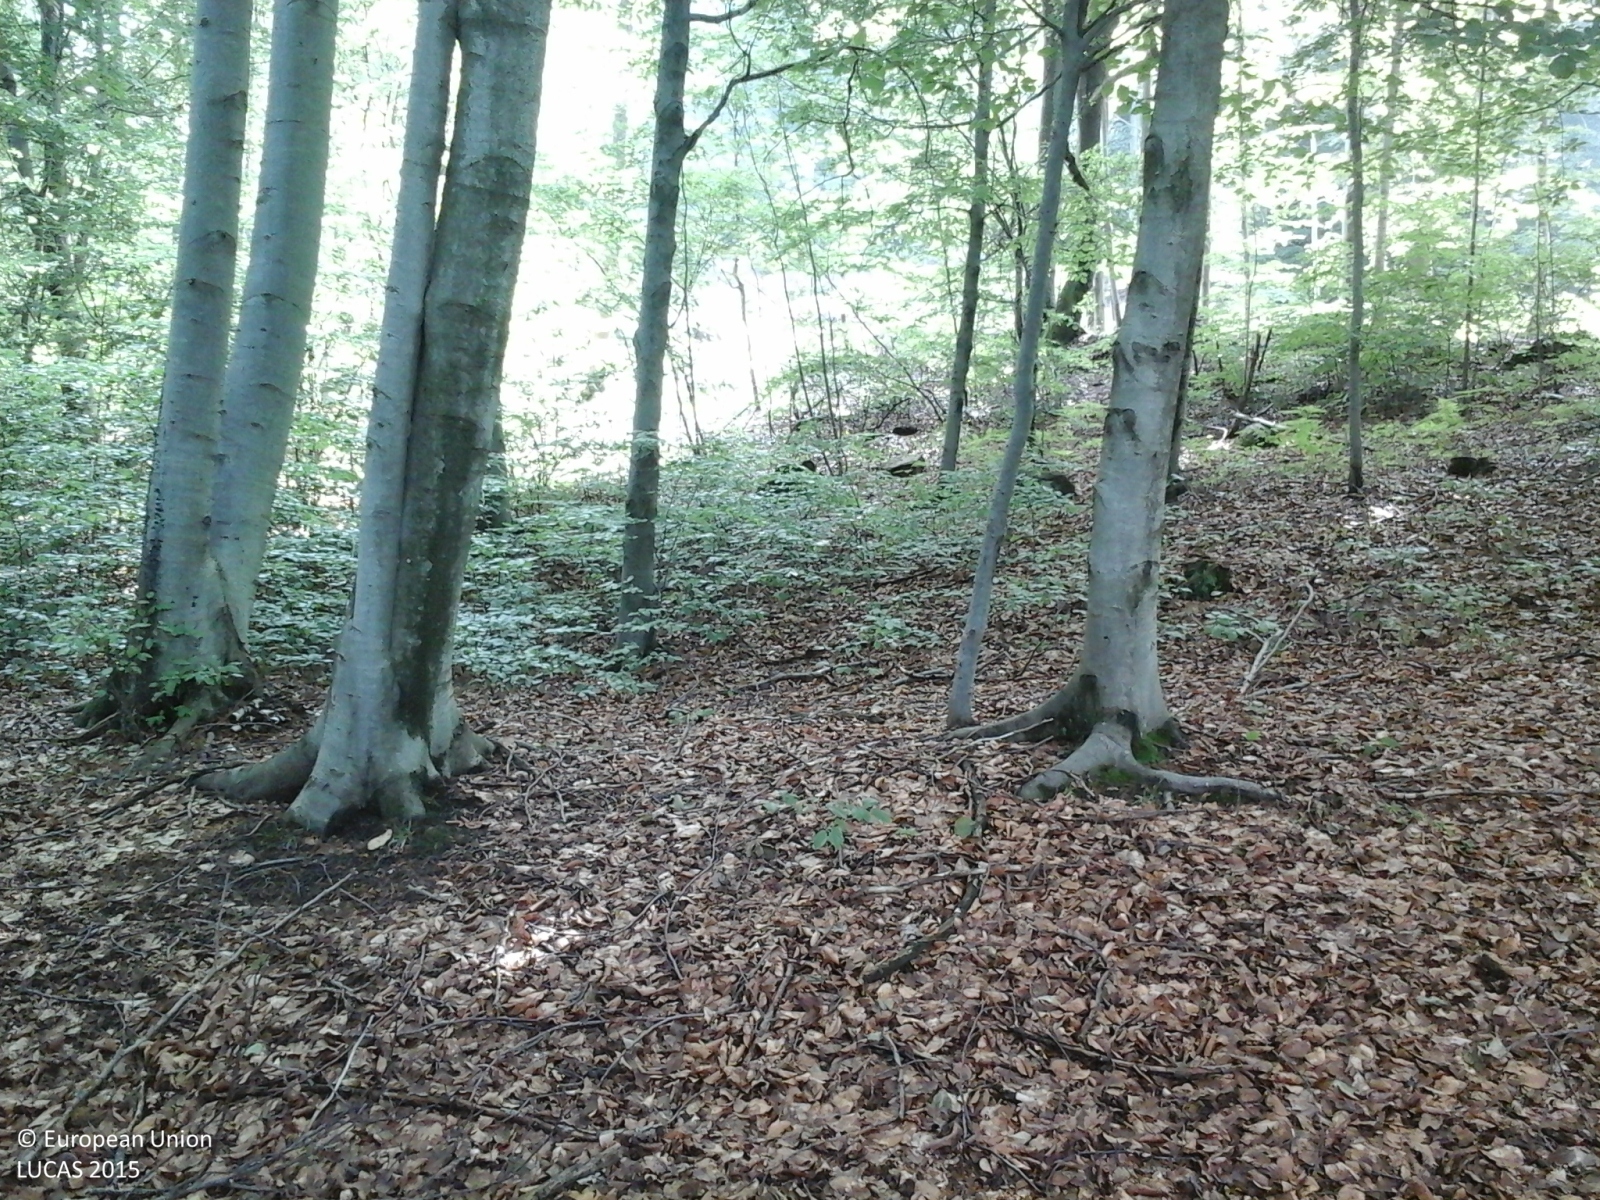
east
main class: Woodland
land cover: Broadleaved woodland
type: beech forest
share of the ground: > 75 %
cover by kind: broadleaved forest trees 100 %
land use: Forestry
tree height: > 5 m
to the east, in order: Broadleaved woodland; Tracks; Broadleaved woodland; Paved roads, cycling and walking lanes; Broadleaved woodland; Paved roads, cycling and walking lanes; Broadleaved woodland
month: June
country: IT
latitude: 45.7790
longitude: 8.2920
